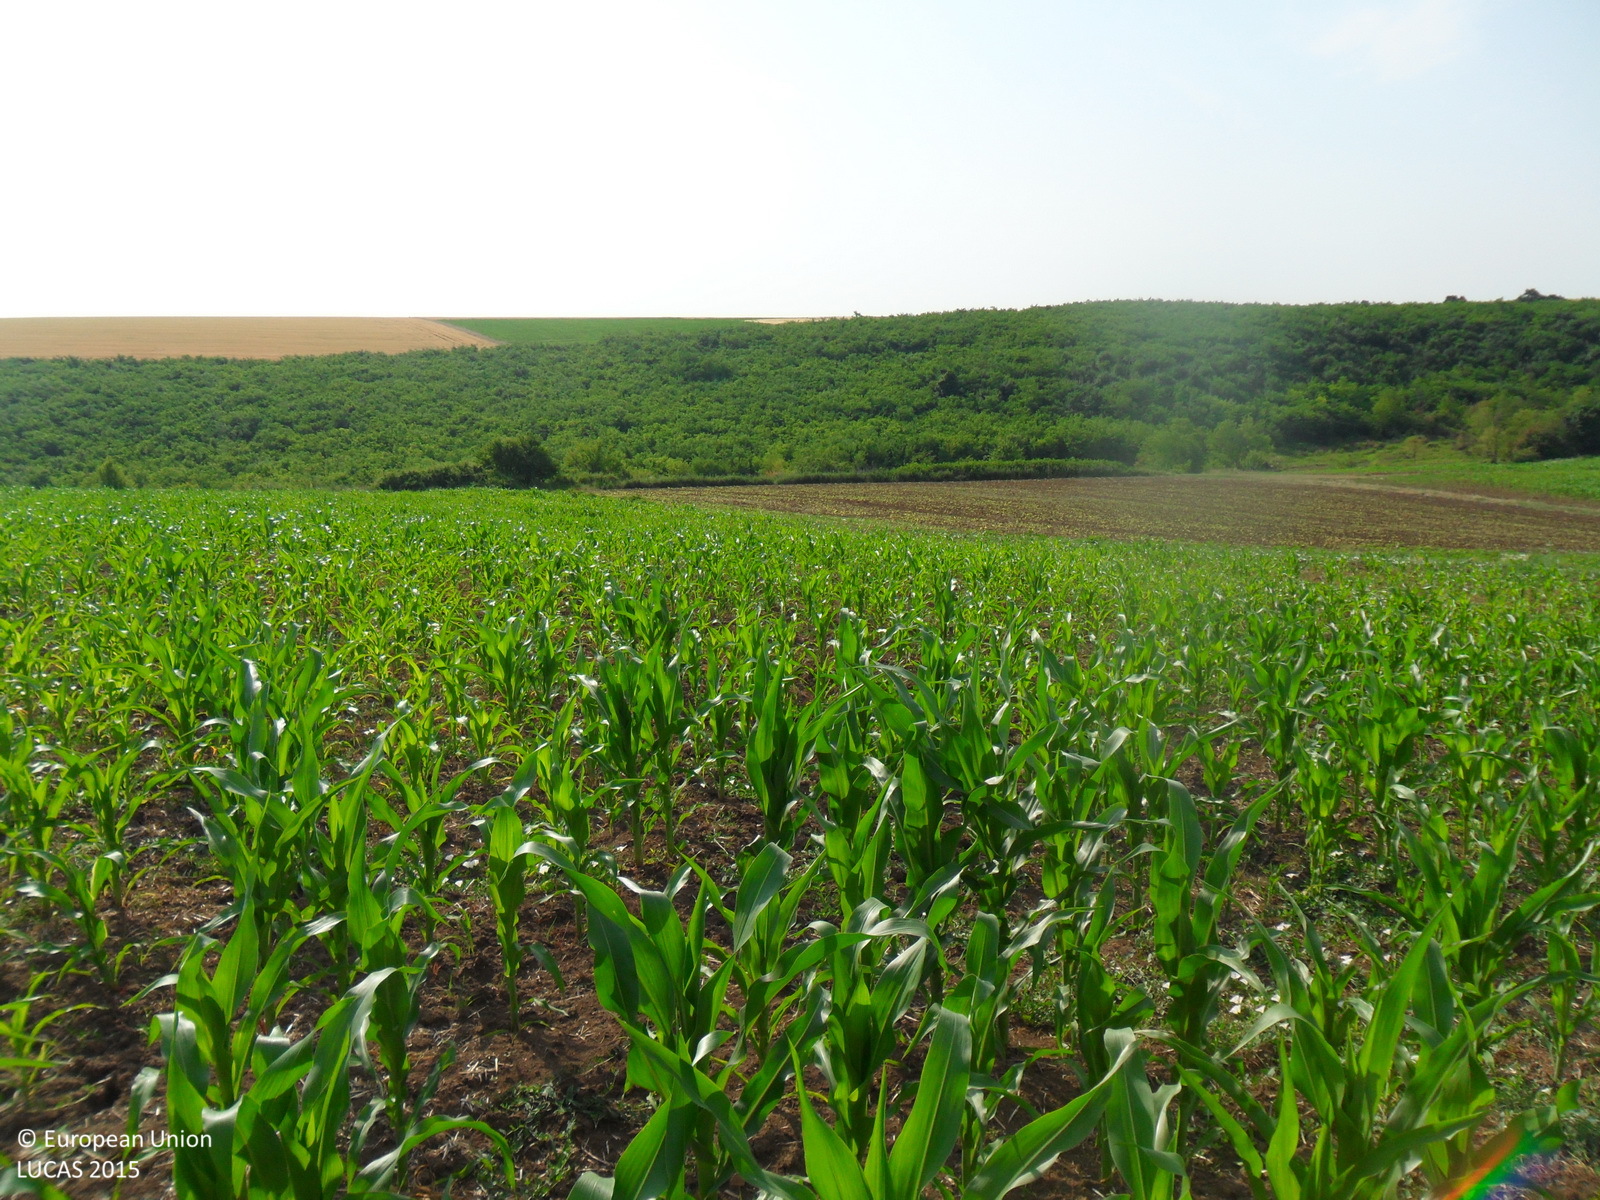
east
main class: Cropland
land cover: Maize
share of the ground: 50 - 75 %
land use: Agriculture (excluding fallow land and kitchen gardens)
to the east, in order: Maize; Grassland with sparse tree/shrub cover; Spontaneously vegetated surfaces; Broadleaved woodland
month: June
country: BG
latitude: 43.6741
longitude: 26.8728
